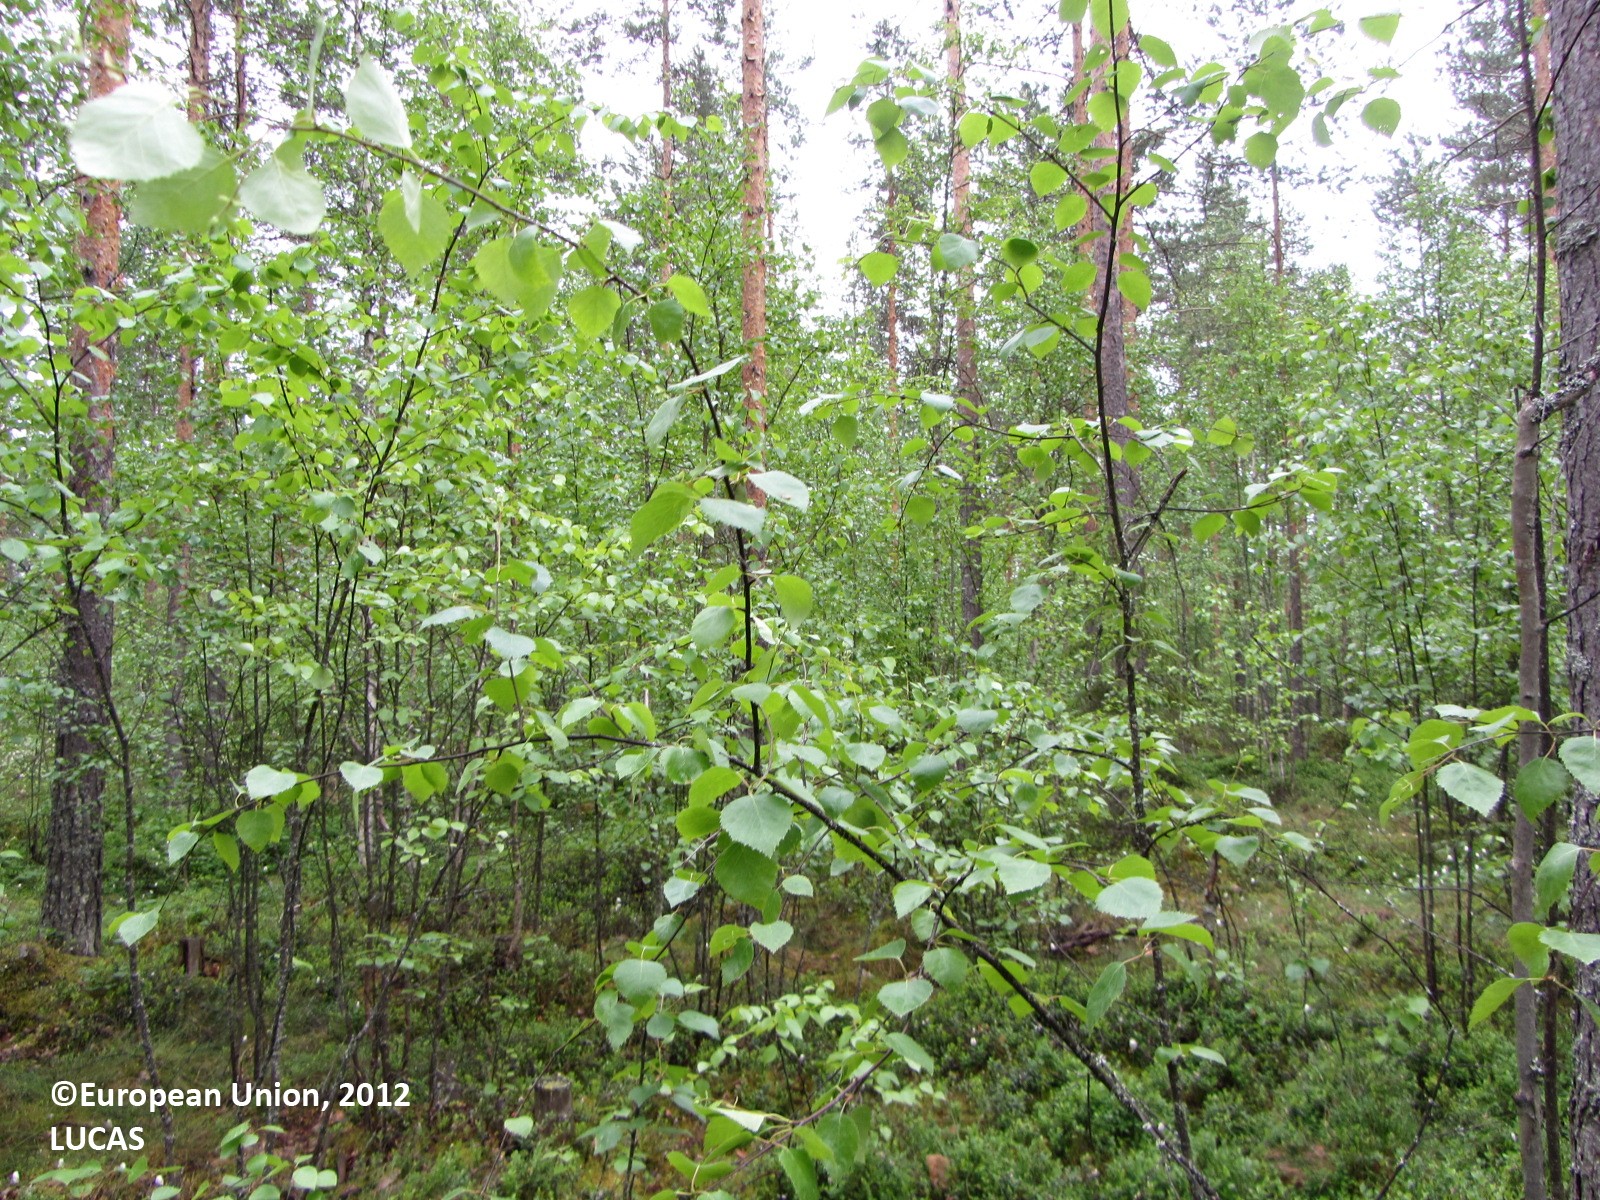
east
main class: Woodland
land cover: Pine dominated mixed woodland
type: boreal forest
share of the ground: 50 - 75 %
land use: Forestry
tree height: > 5 m
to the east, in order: Pine dominated mixed woodland; Ditches and canals; Pine dominated mixed woodland; Ditches and canals; Pine dominated mixed woodland; Ditches and canals; Pine dominated mixed woodland; Ditches and canals; Pine dominated mixed woodland; Ditches and canals; Pine dominated mixed woodland; Ditches and canals; Pine dominated mixed woodland
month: June
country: FI
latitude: 61.9634
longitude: 25.1948
